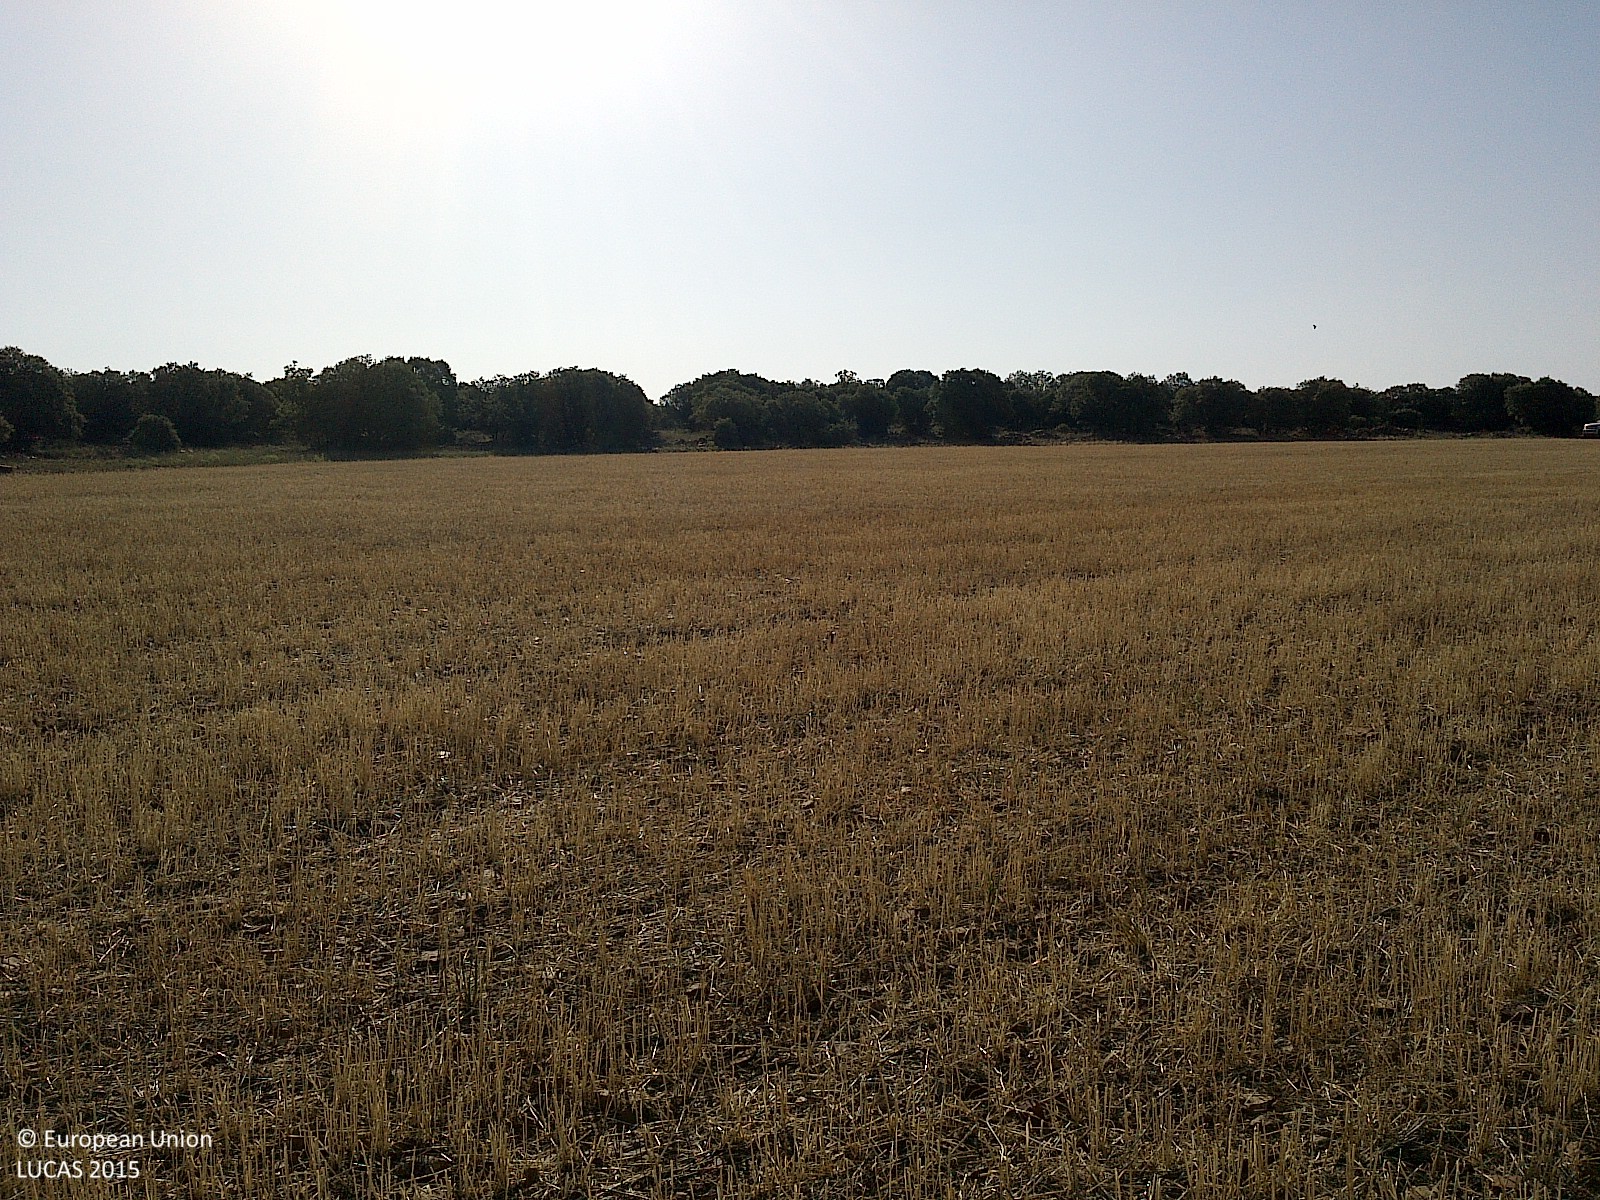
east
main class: Cropland
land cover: Barley
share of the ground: < 10 %
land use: Agriculture (excluding fallow land and kitchen gardens)
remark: Harvested field
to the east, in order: Barley; Broadleaved woodland; Barley
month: July
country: ES
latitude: 41.4675
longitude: -1.9671
